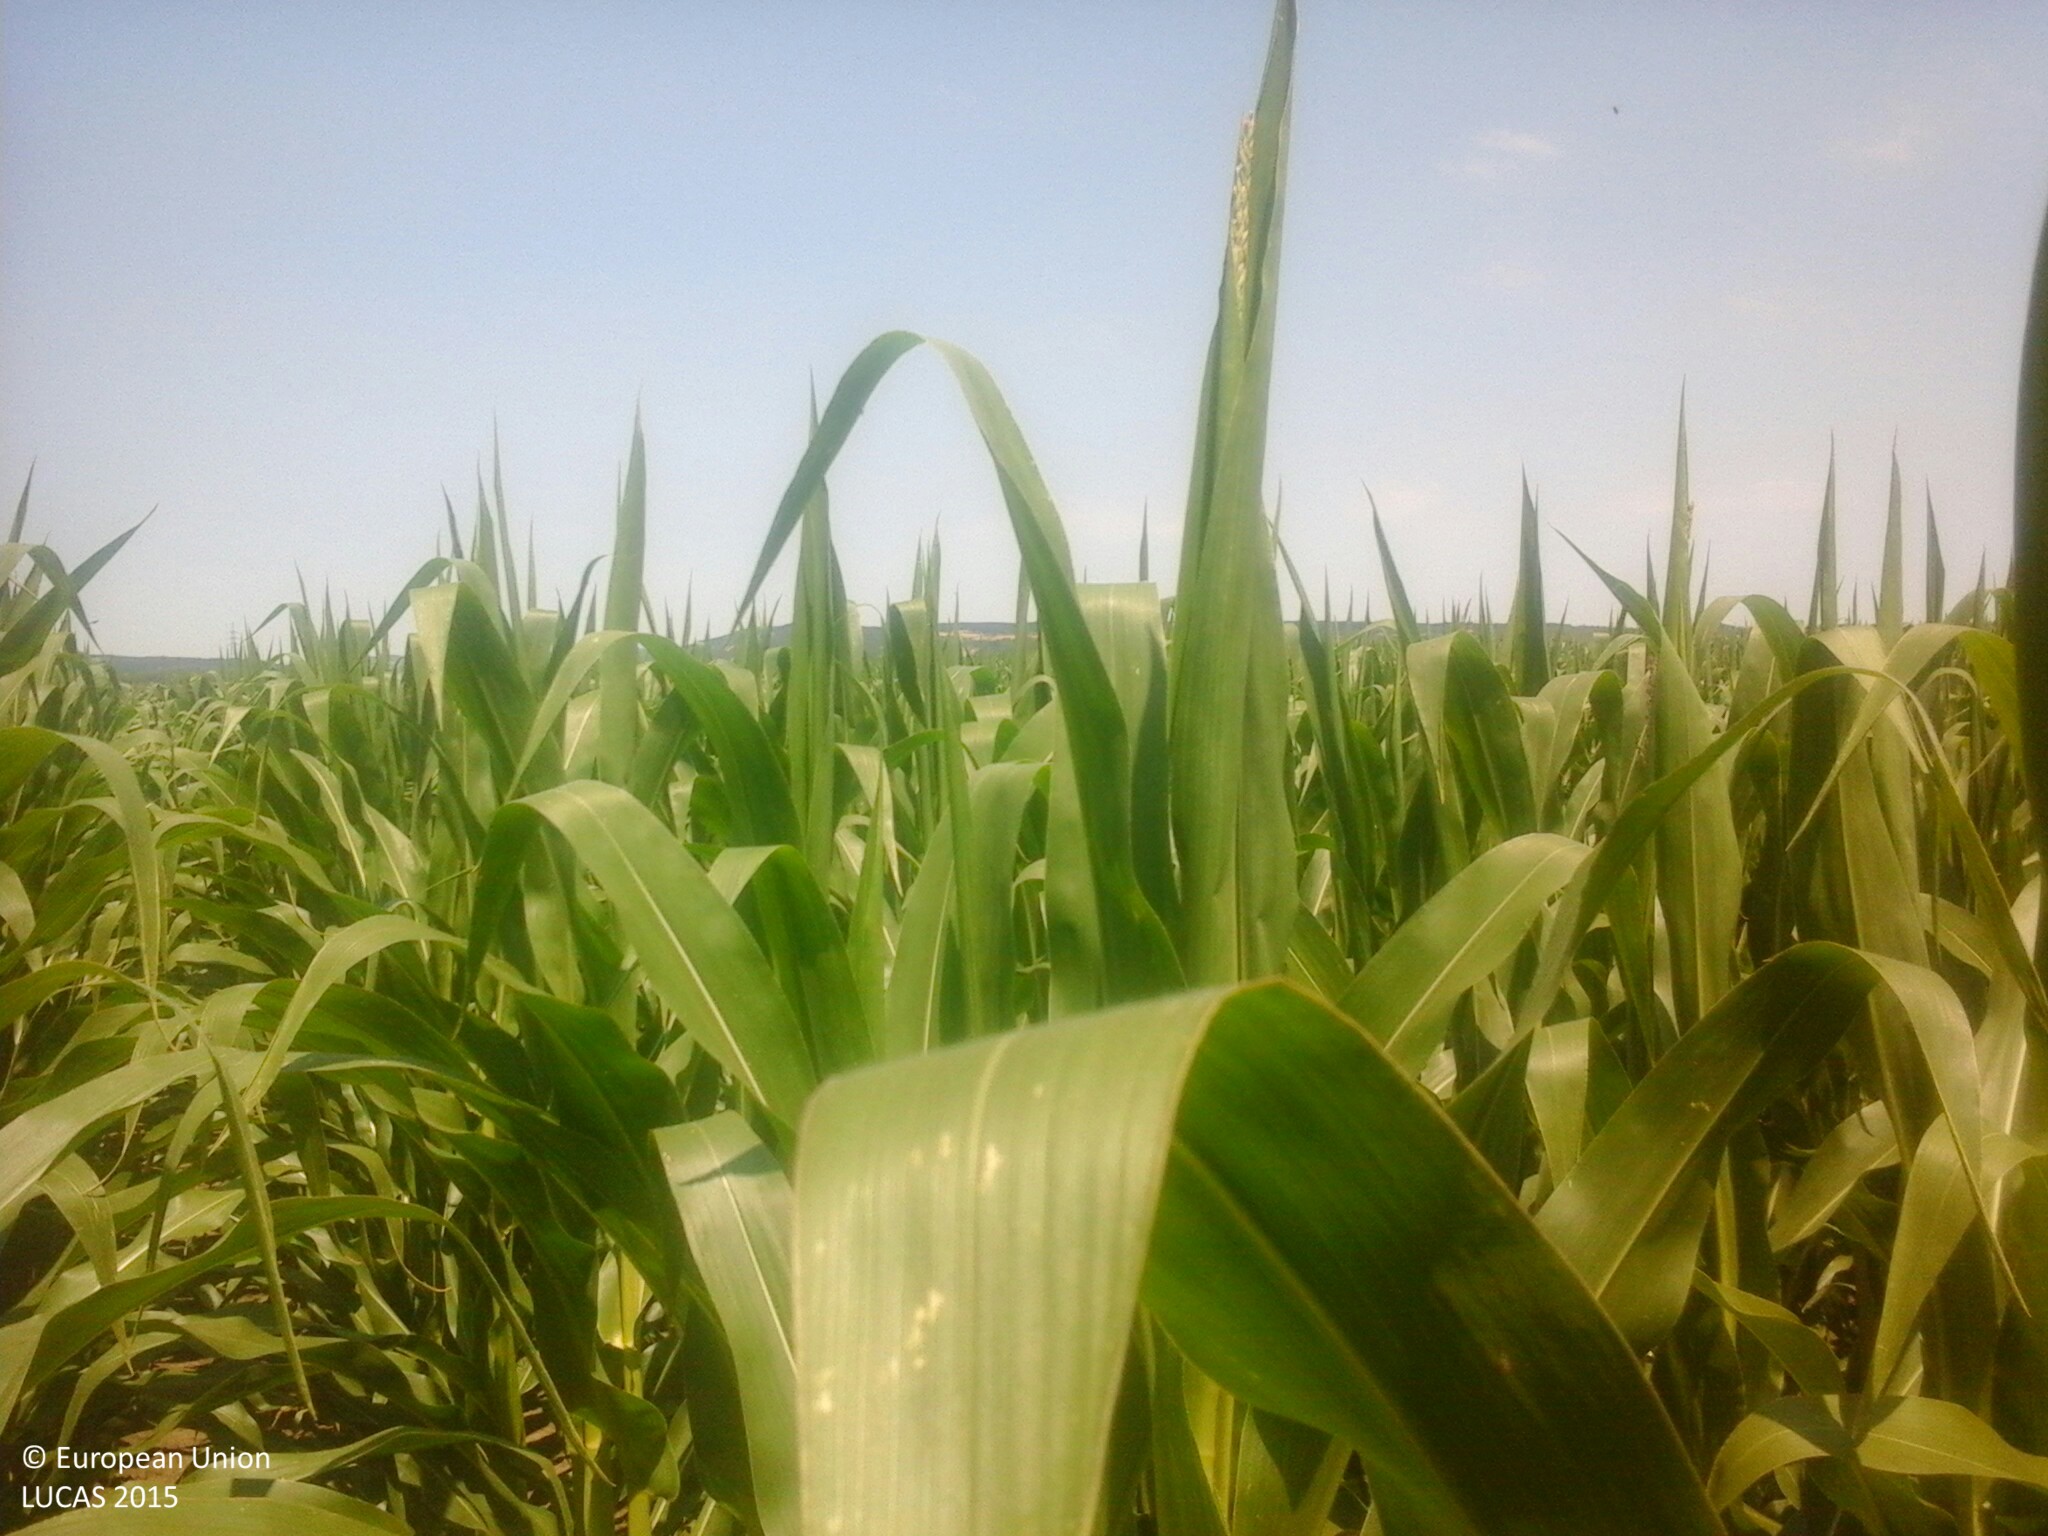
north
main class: Cropland
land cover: Maize
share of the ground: > 75 %
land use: Agriculture (excluding fallow land and kitchen gardens)
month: July
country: HU
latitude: 47.4729
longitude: 18.5724
